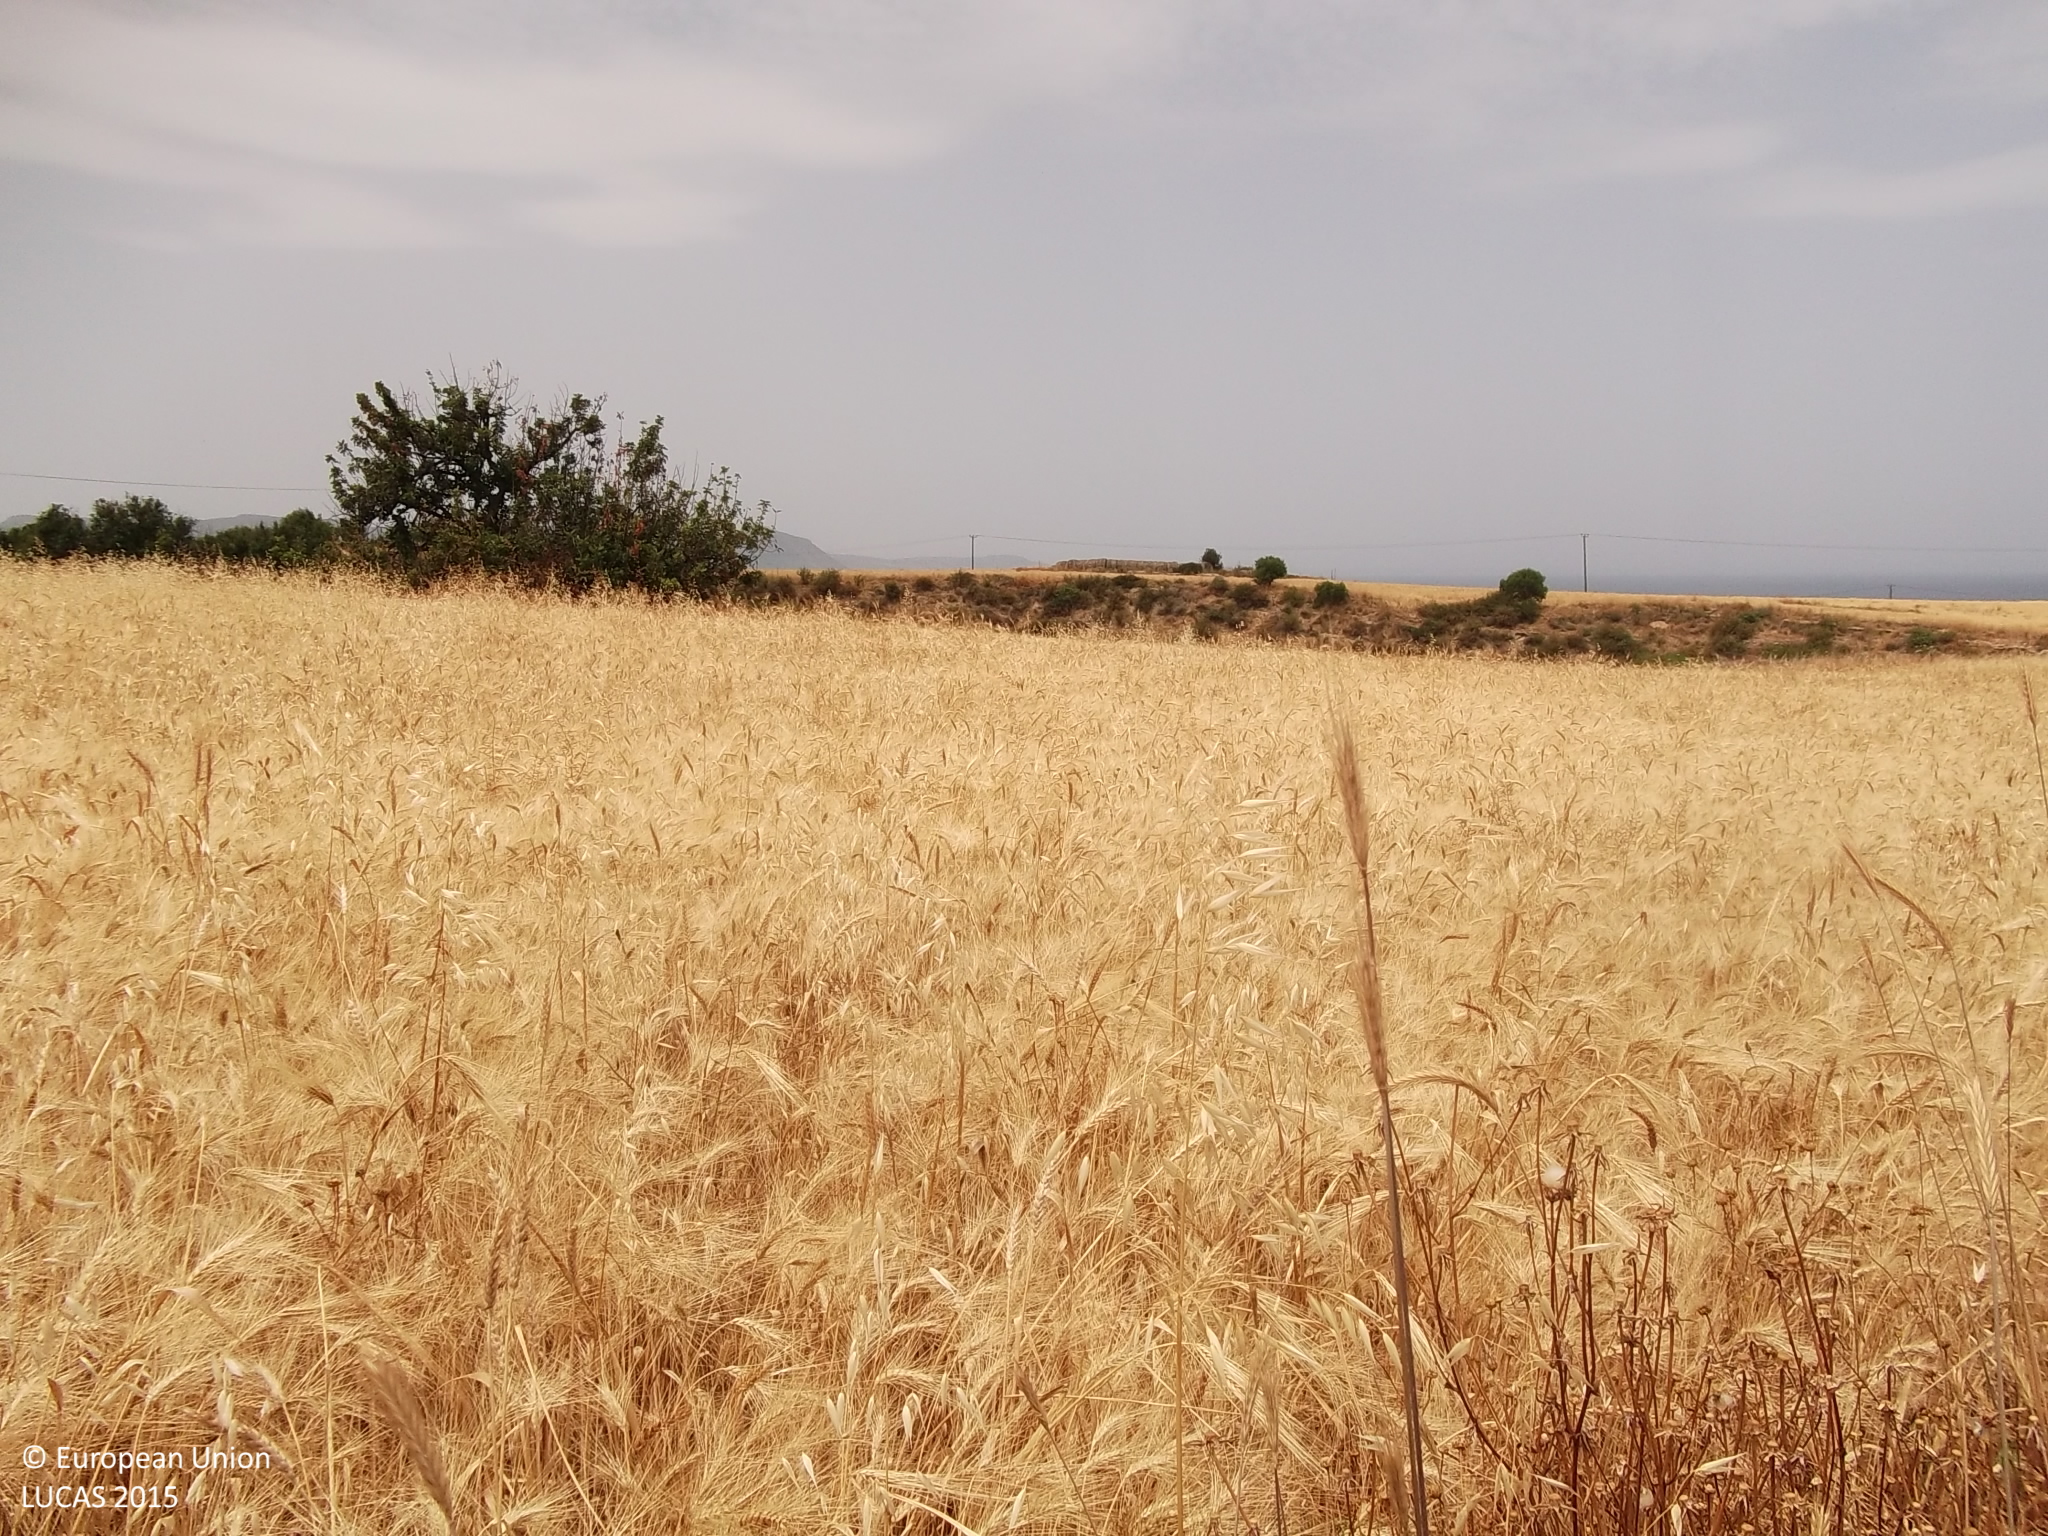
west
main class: Grassland
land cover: Grassland with sparse tree/shrub cover
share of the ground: > 75 %
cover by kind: herbaceous plants 85 %, broadleaved forest trees 5 %, shrubs 5 %, unconsolidated bare surface 5 %
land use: Semi-natural and natural areas not in use
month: May
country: CY
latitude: 35.0418
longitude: 32.4633
